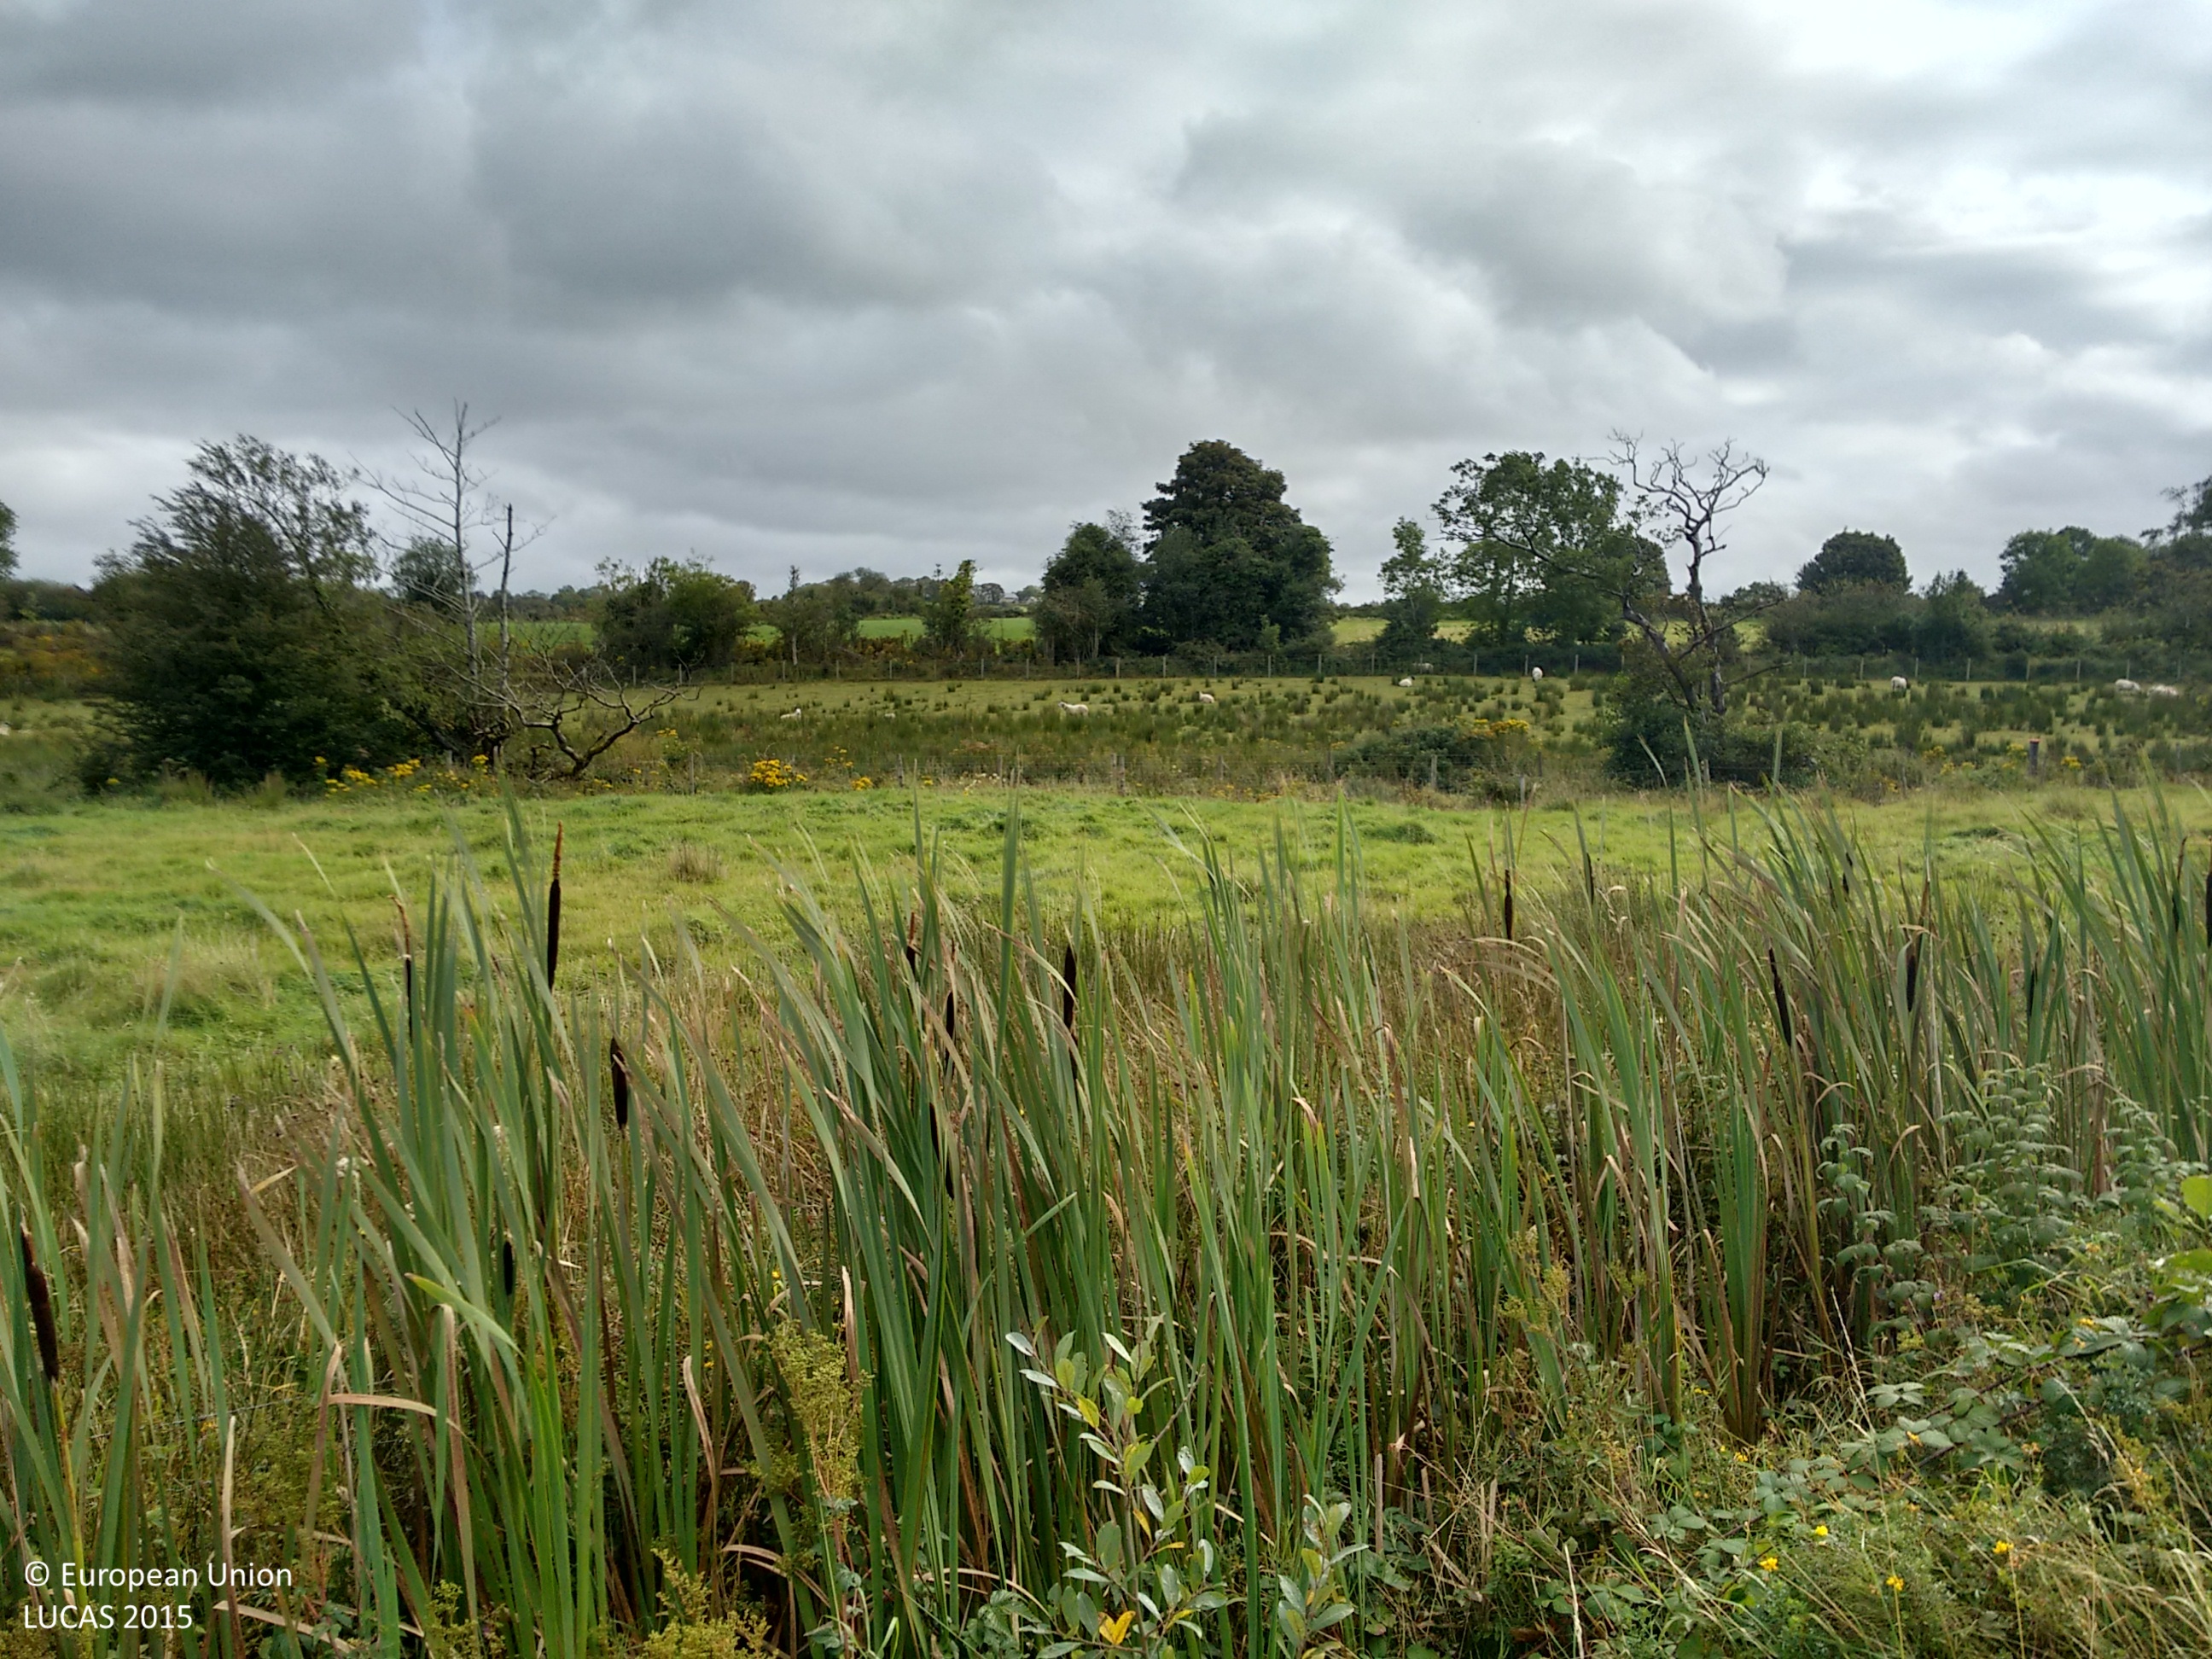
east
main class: Grassland
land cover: Grassland without tree/shrub cover
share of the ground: > 75 %
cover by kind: herbaceous plants 100 %
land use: Agriculture (excluding fallow land and kitchen gardens)
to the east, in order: Ditches and canals; Grassland without tree/shrub cover; Fences; Ditches and canals; Fences; Grassland without tree/shrub cover; Fences; Abandoned hedges; Tracks; Fences; Grassland without tree/shrub cover; Broadleaved woodland; Grassland without tree/shrub cover
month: September
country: IE
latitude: 54.9213
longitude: -7.5852
